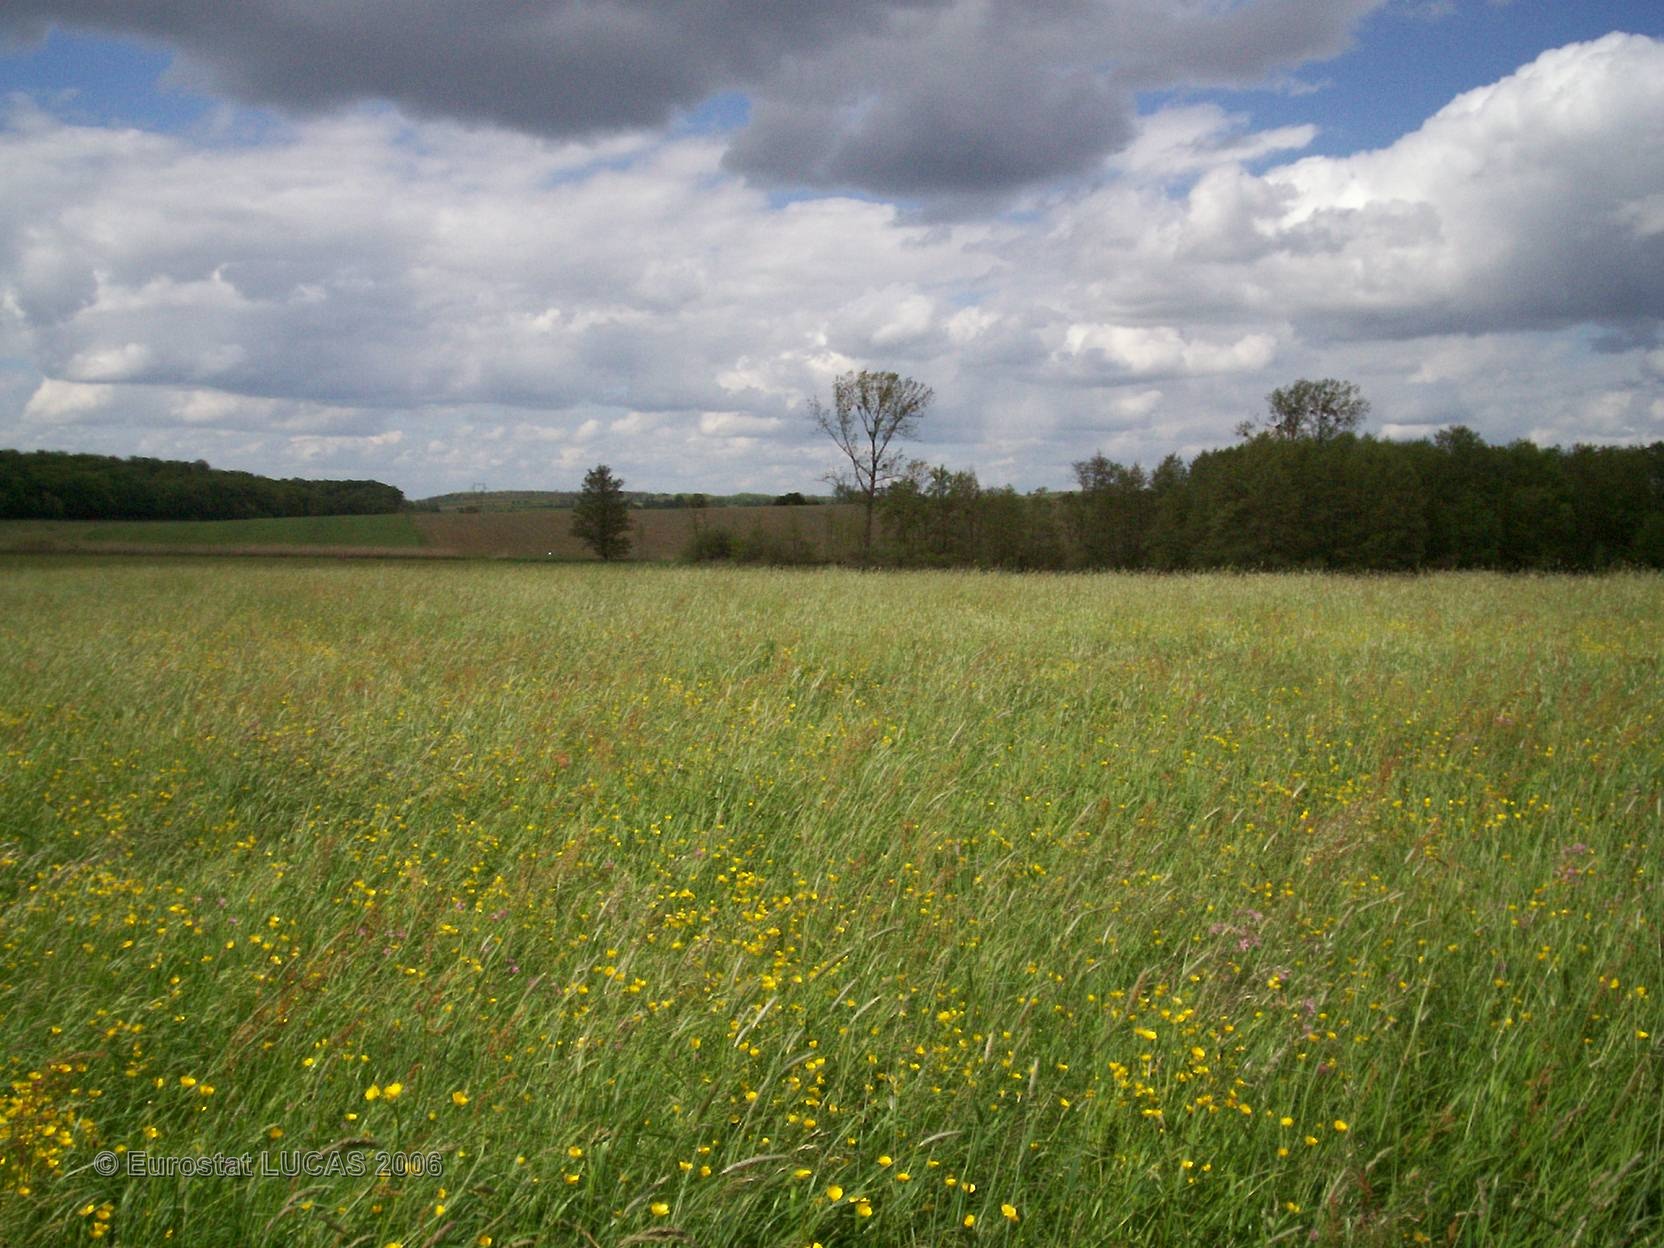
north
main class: Grassland
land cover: Grassland without tree/shrub cover
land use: Agriculture (excluding fallow land and kitchen gardens)
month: May
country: FR
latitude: 48.6089
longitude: 6.7862
